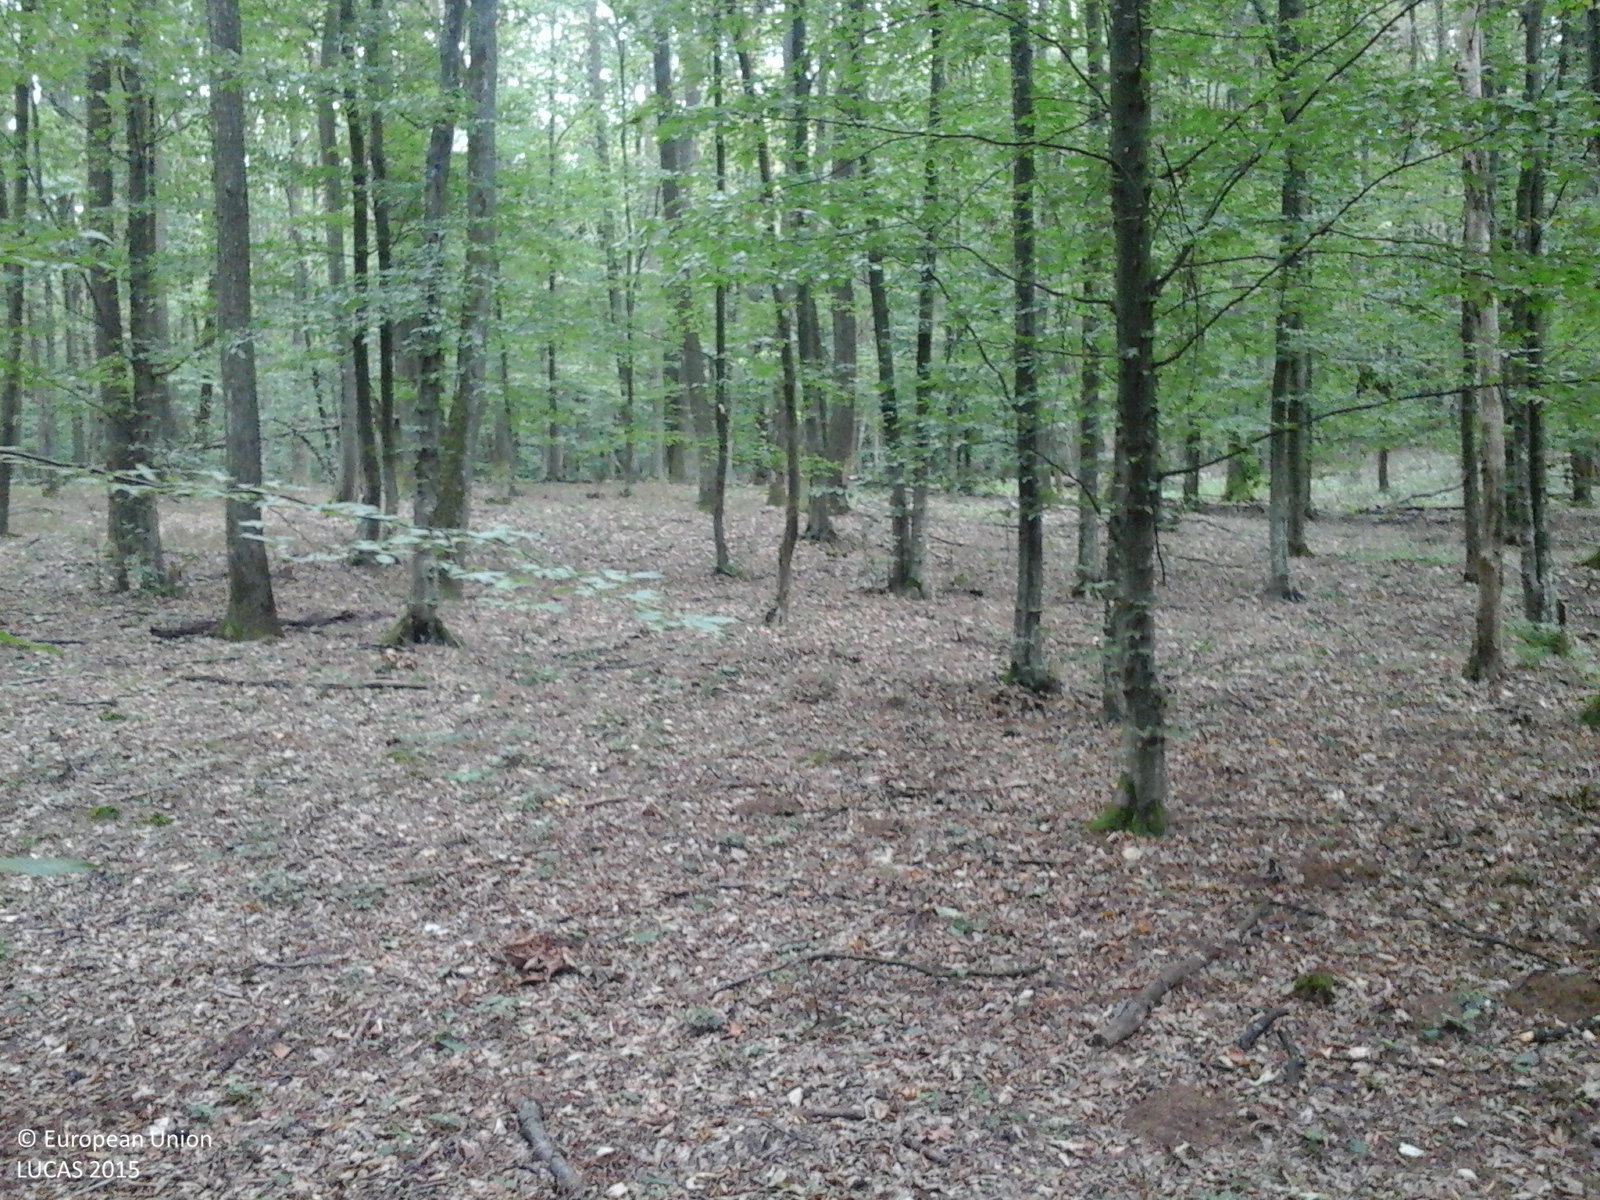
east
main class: Woodland
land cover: Broadleaved woodland
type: acidophilous oak and oak-birch forest
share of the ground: > 75 %
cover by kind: broadleaved forest trees 100 %
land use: Forestry
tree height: > 5 m
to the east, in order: Broadleaved woodland
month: September
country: RO
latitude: 47.3991
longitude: 22.6596
